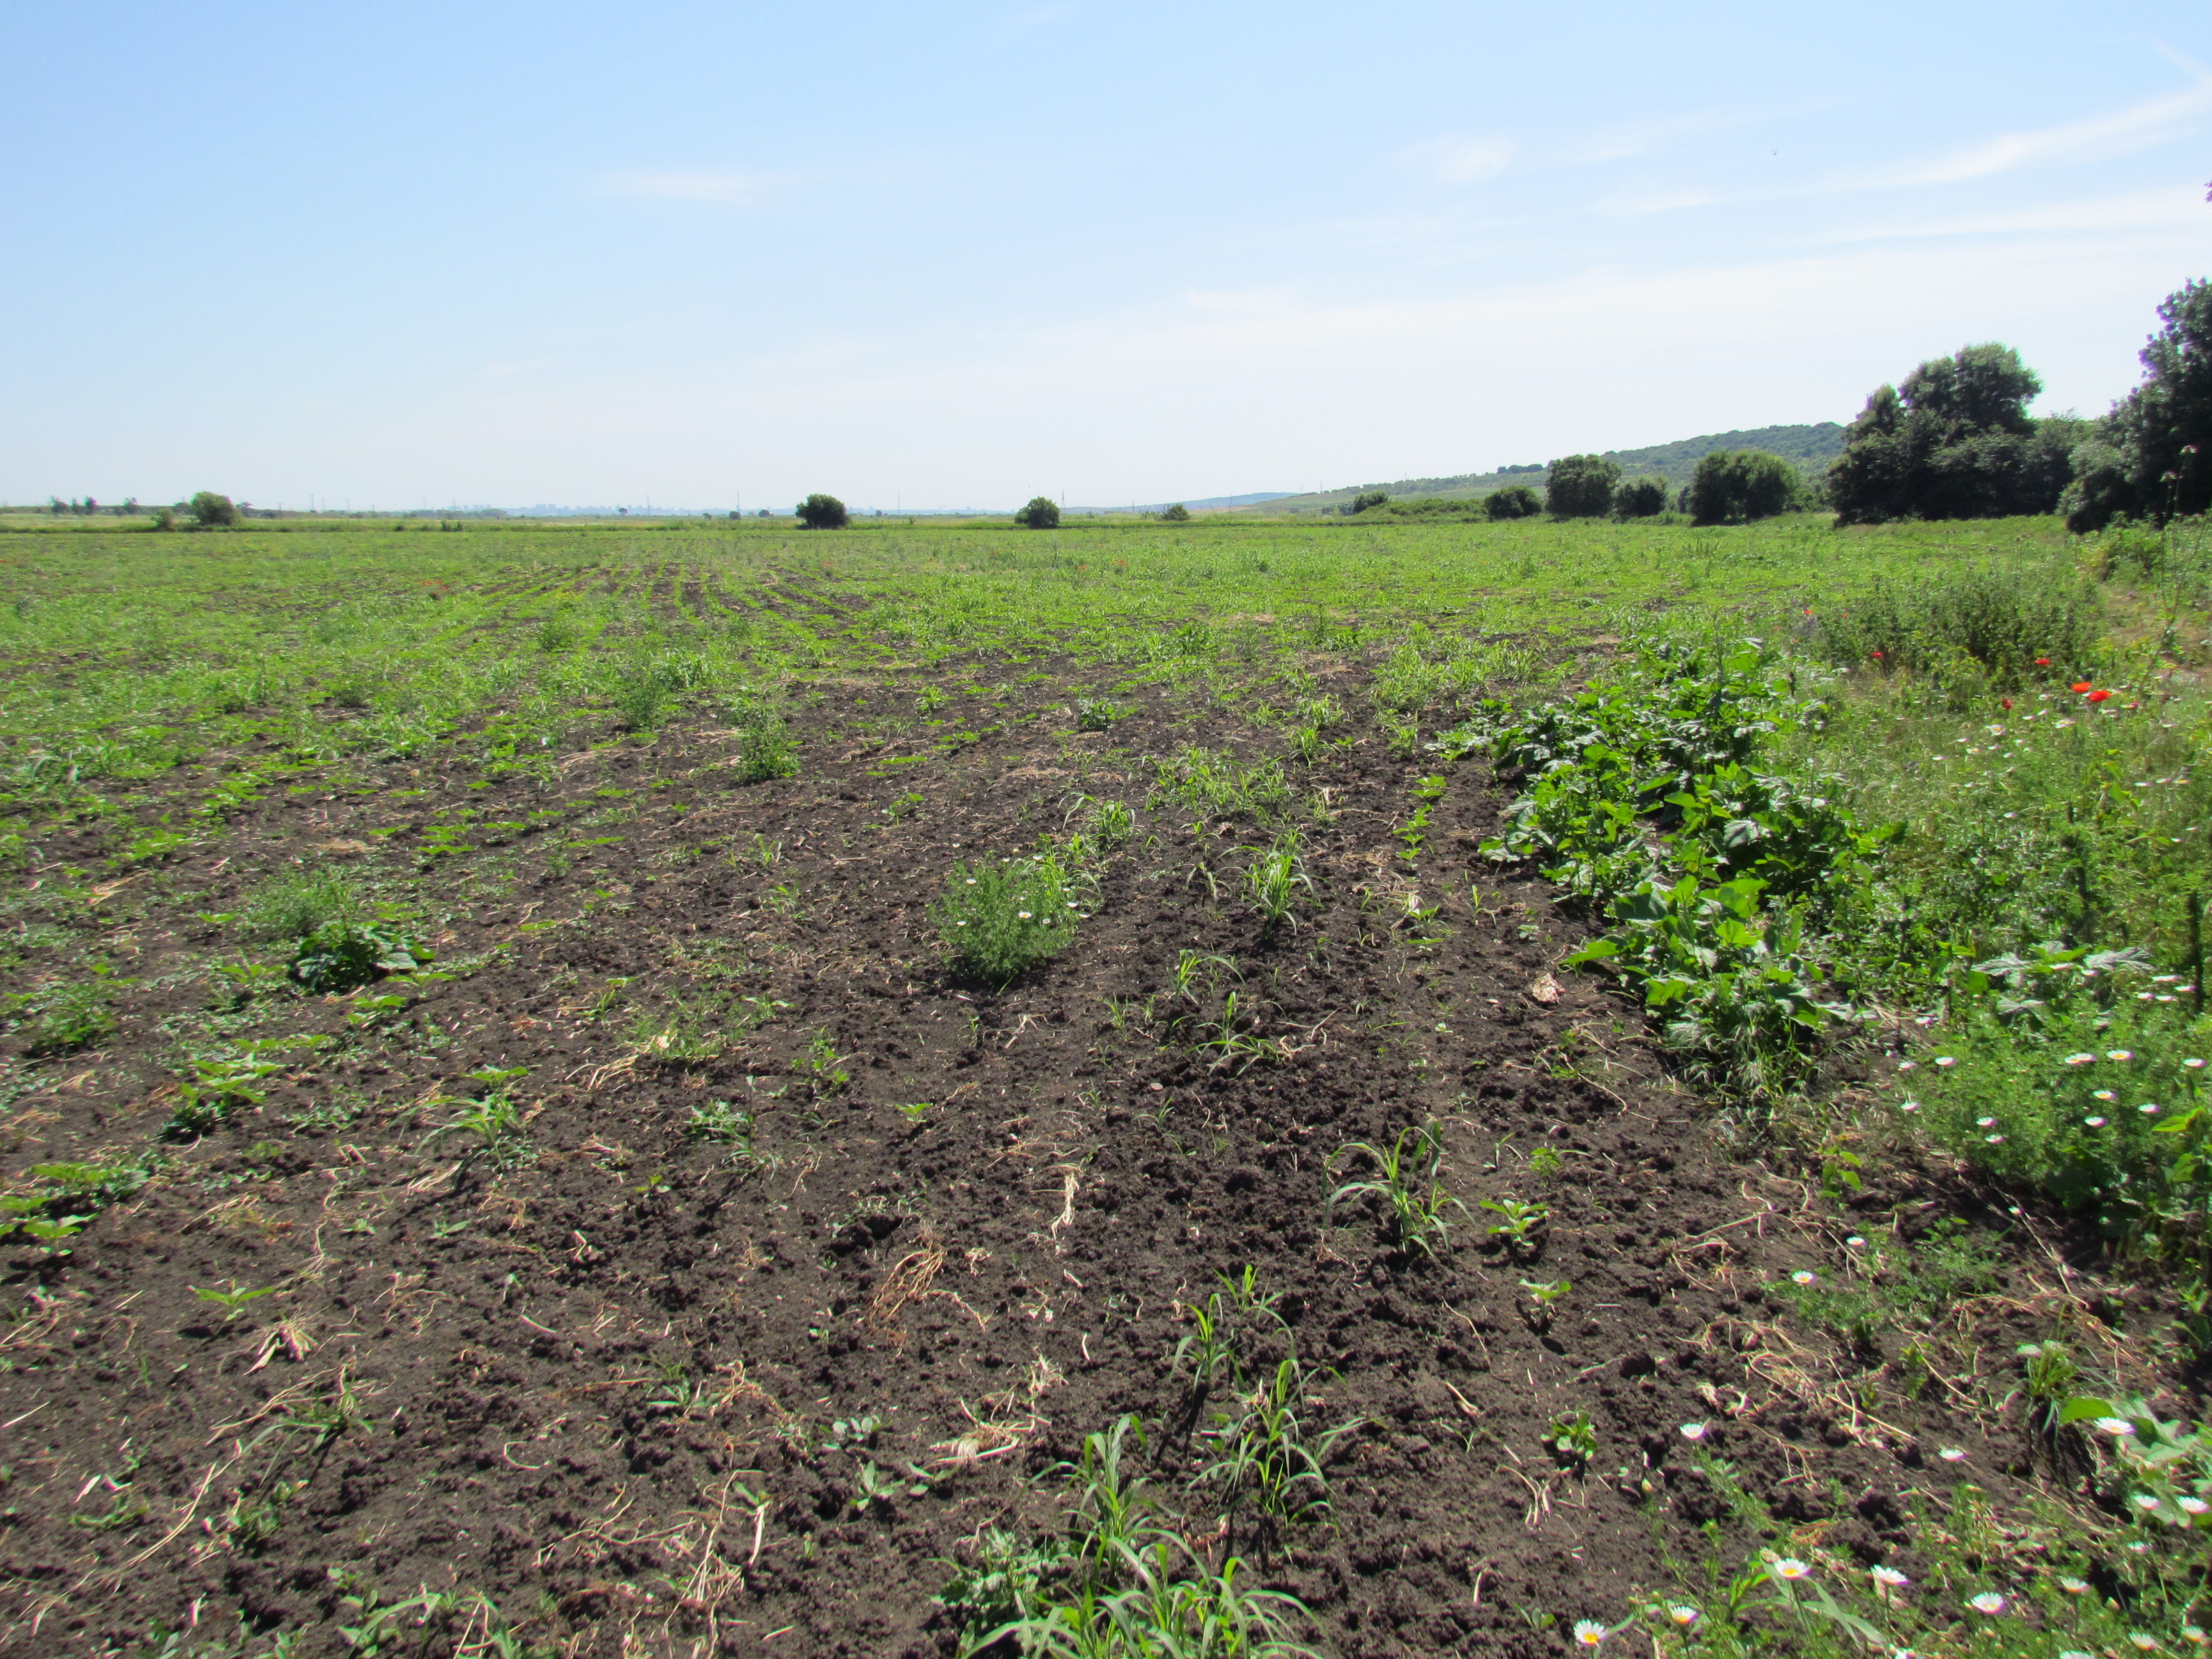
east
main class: Cropland
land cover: Sunflower
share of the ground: 10 - 25 %
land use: Agriculture (excluding fallow land and kitchen gardens)
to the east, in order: Sunflower; Grass margins; Ditches and canals; Grassland with sparse tree/shrub cover; Tracks; Barley
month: June
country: BG
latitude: 42.4961
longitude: 27.3056
